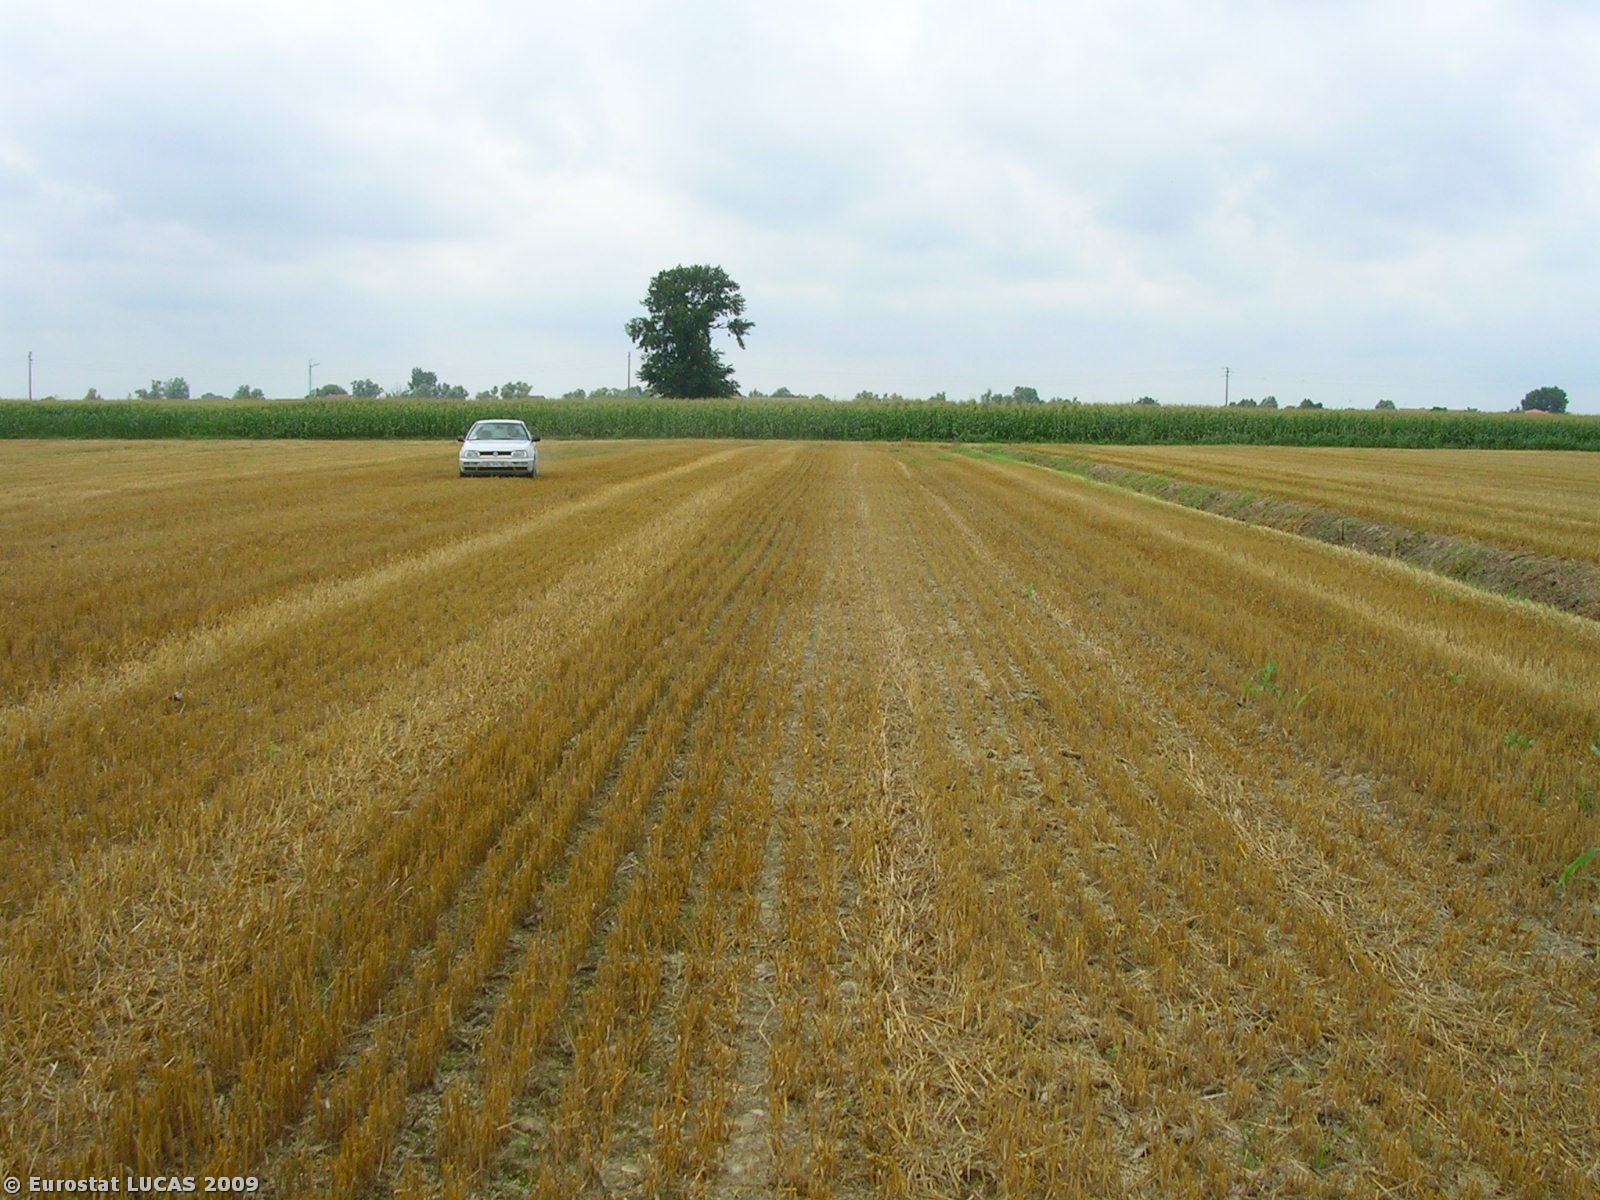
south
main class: Cropland
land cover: Common wheat
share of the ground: > 75 %
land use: Agriculture (excluding fallow land and kitchen gardens)
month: July
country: IT
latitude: 45.2502
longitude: 12.0479
